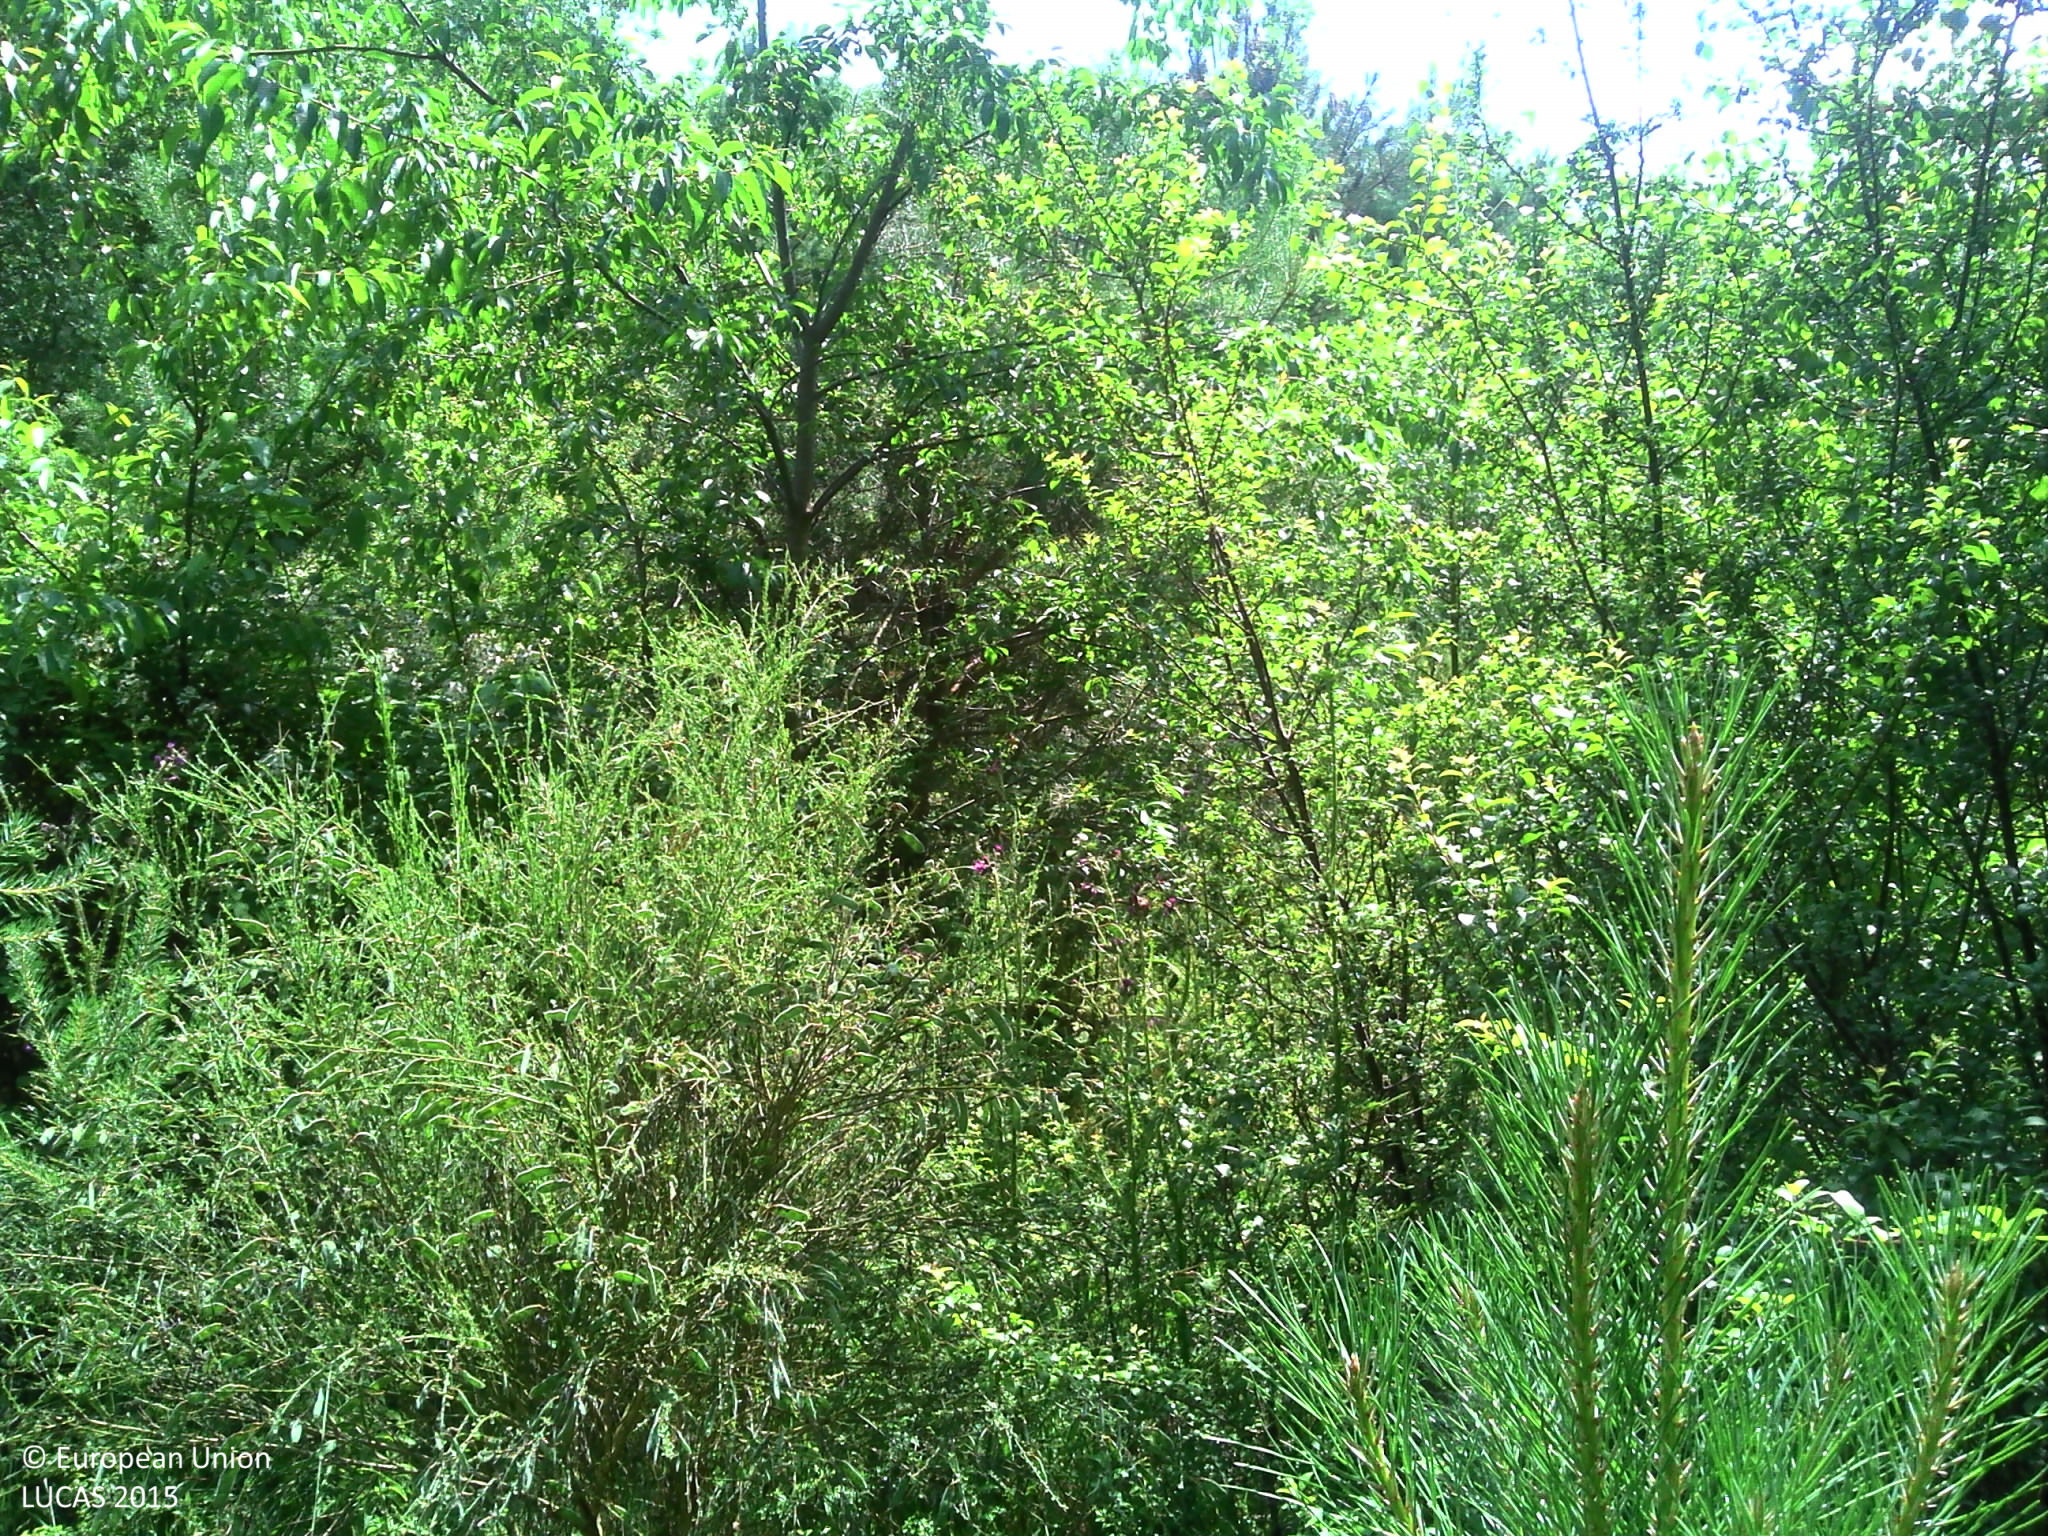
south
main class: Woodland
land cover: Pine dominated mixed woodland
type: thermophilous deciduous forest
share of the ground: > 75 %
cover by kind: coniferous forest trees 30 %, broadleaved forest trees 30 %, herbaceous plants 20 %, unconsolidated bare surface 20 %
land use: Forestry
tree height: > 5 m
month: June
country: FR
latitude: 47.6622
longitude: 2.0124
